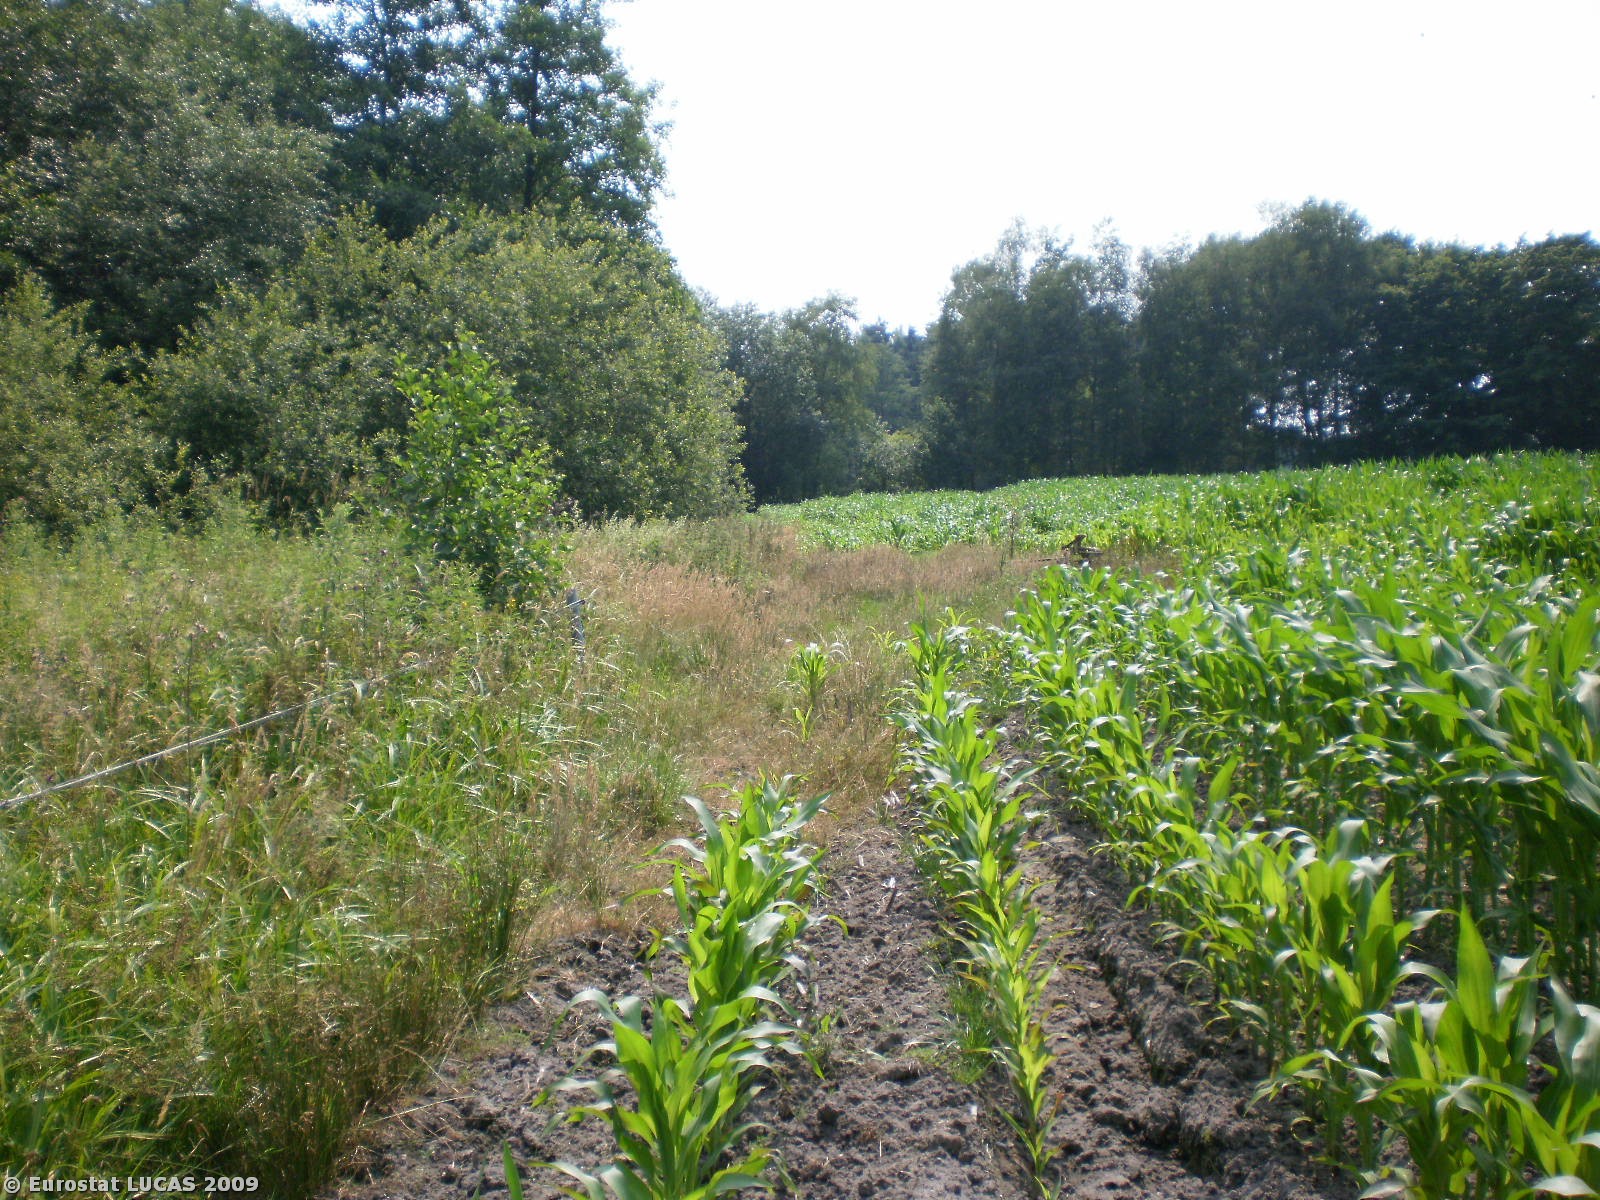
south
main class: Woodland
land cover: Broadleaved woodland
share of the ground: > 75 %
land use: Amenities, museums, leisure
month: July
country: BE
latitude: 51.1409
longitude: 5.5244
